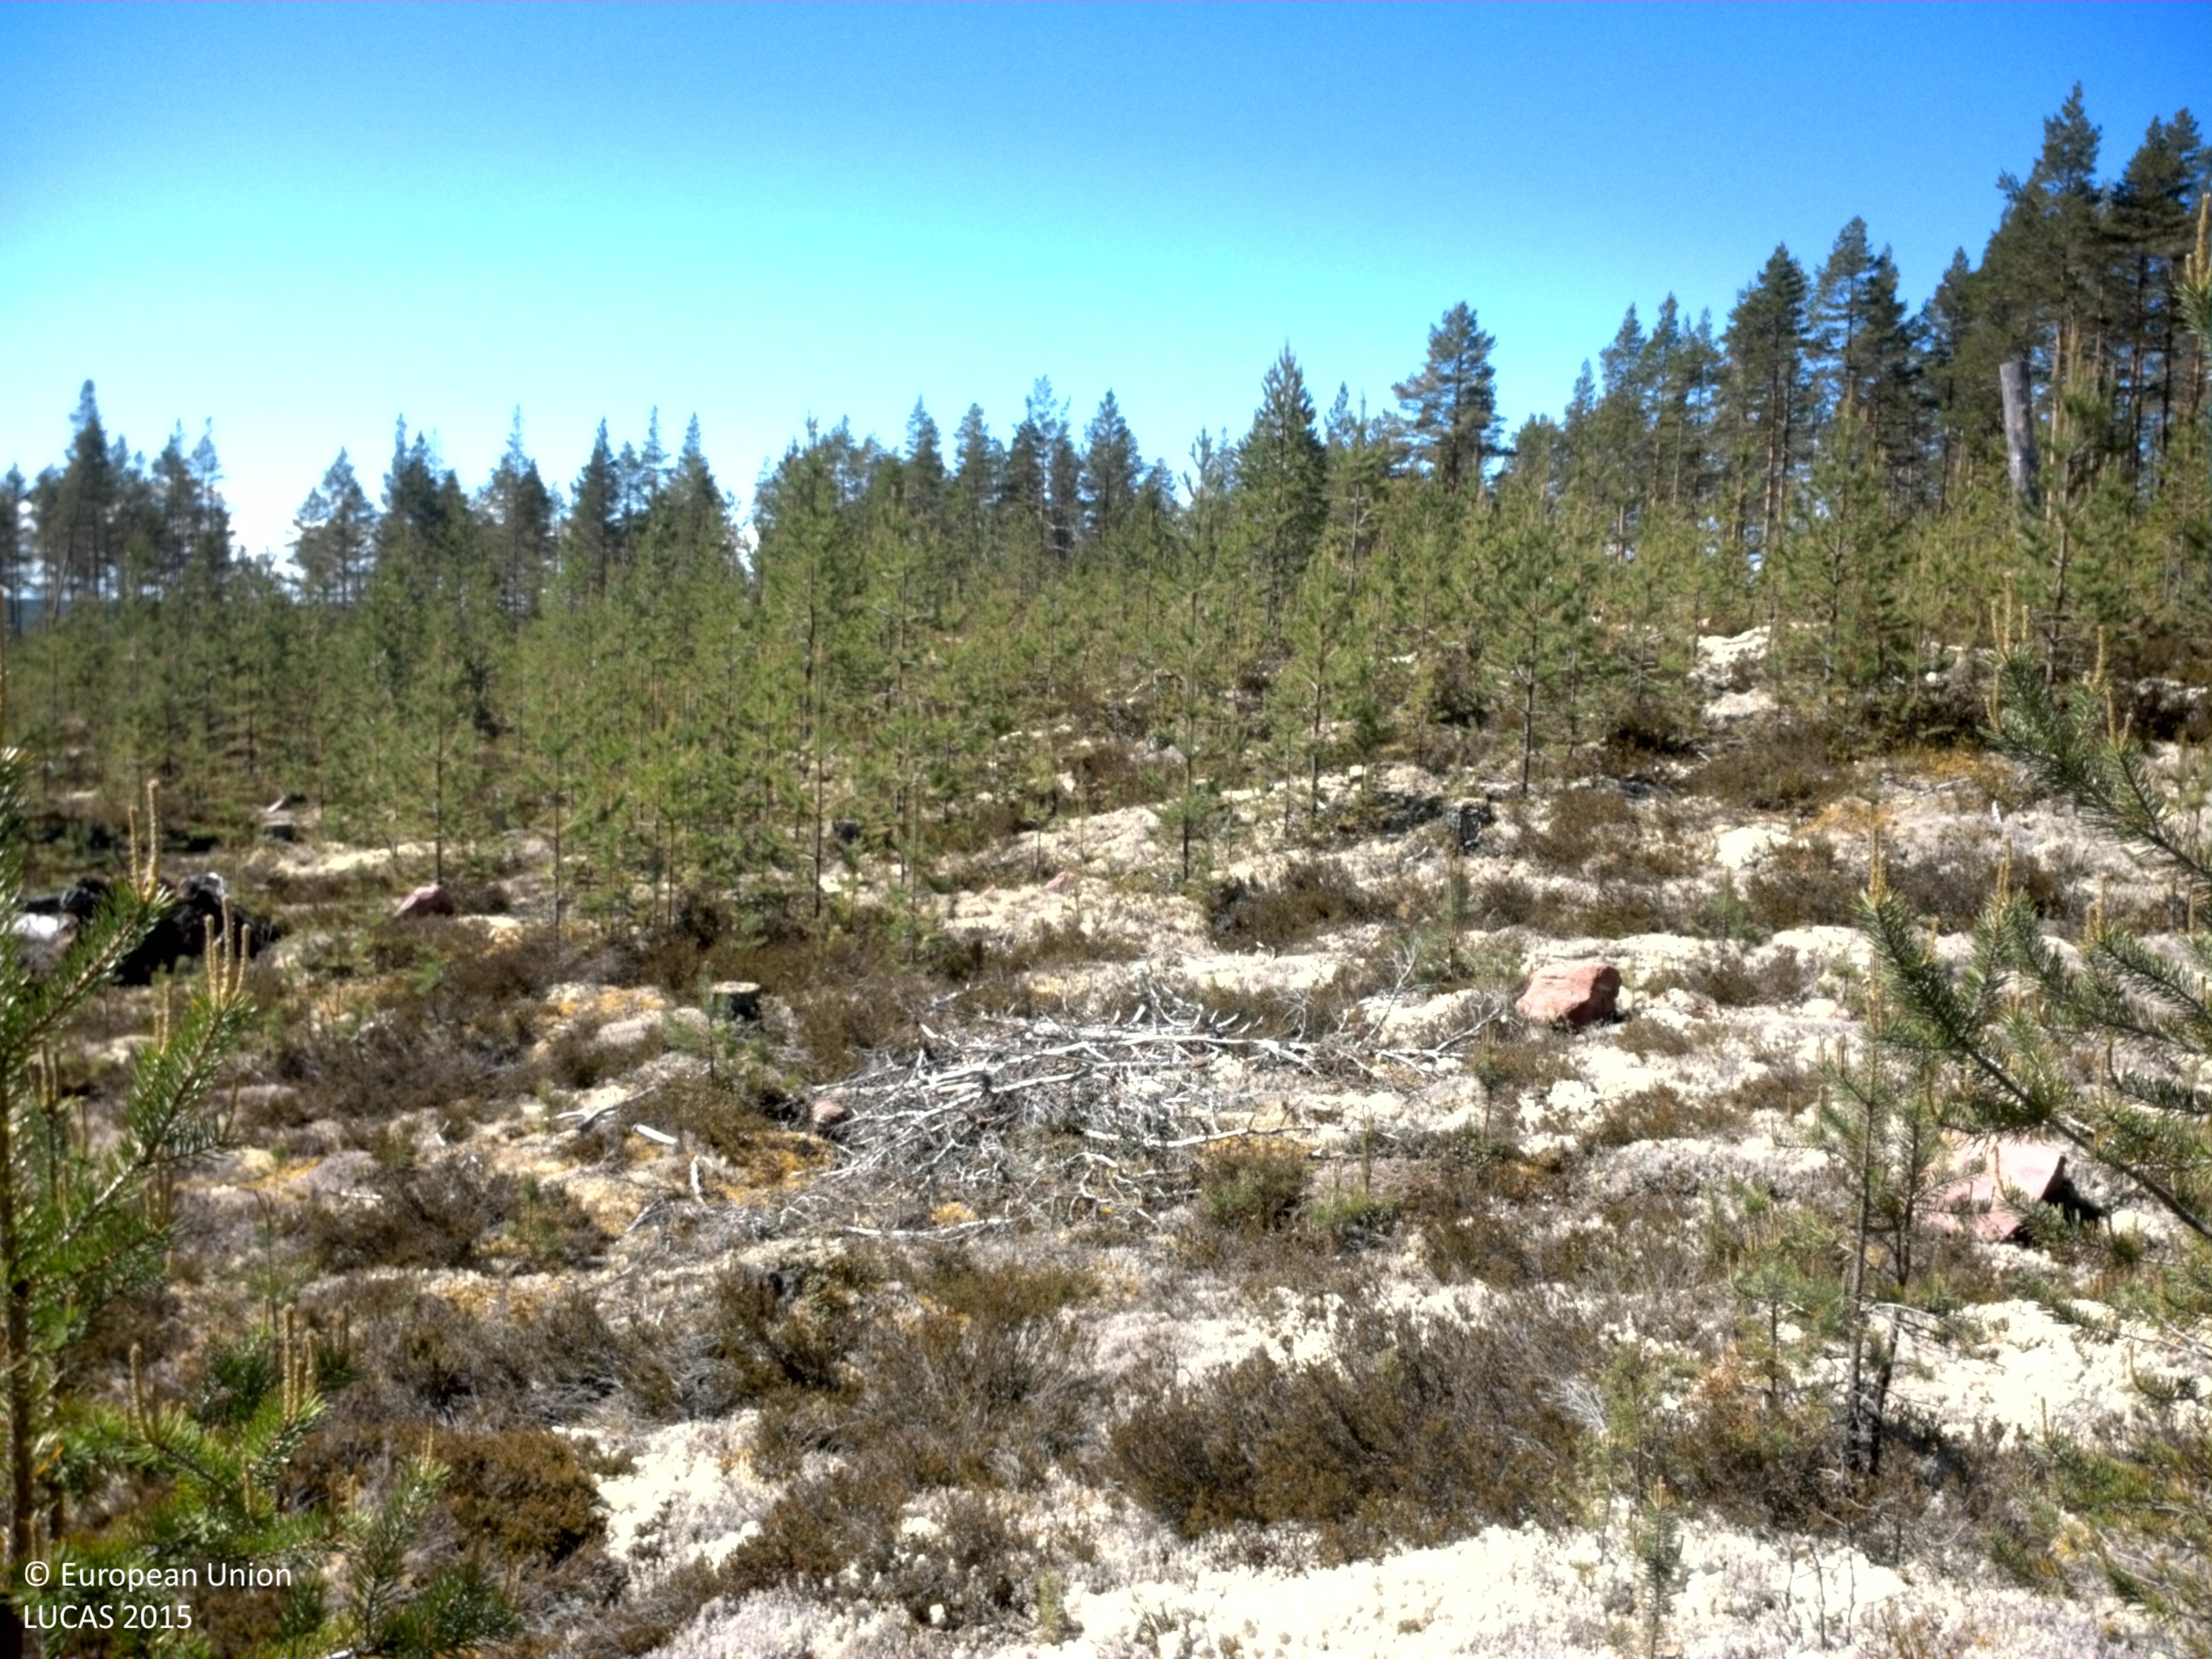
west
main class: Woodland
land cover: Pine dominated coniferous woodland
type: boreal forest
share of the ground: 25 - 50 %
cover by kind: coniferous forest trees 45 %, lichens and mosses 25 %, shrubs 15 %, consolidated bare surface 10 %, herbaceous plants 5 %
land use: Forestry
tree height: < 5 m
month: June
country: SE
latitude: 61.3597
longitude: 13.6343
